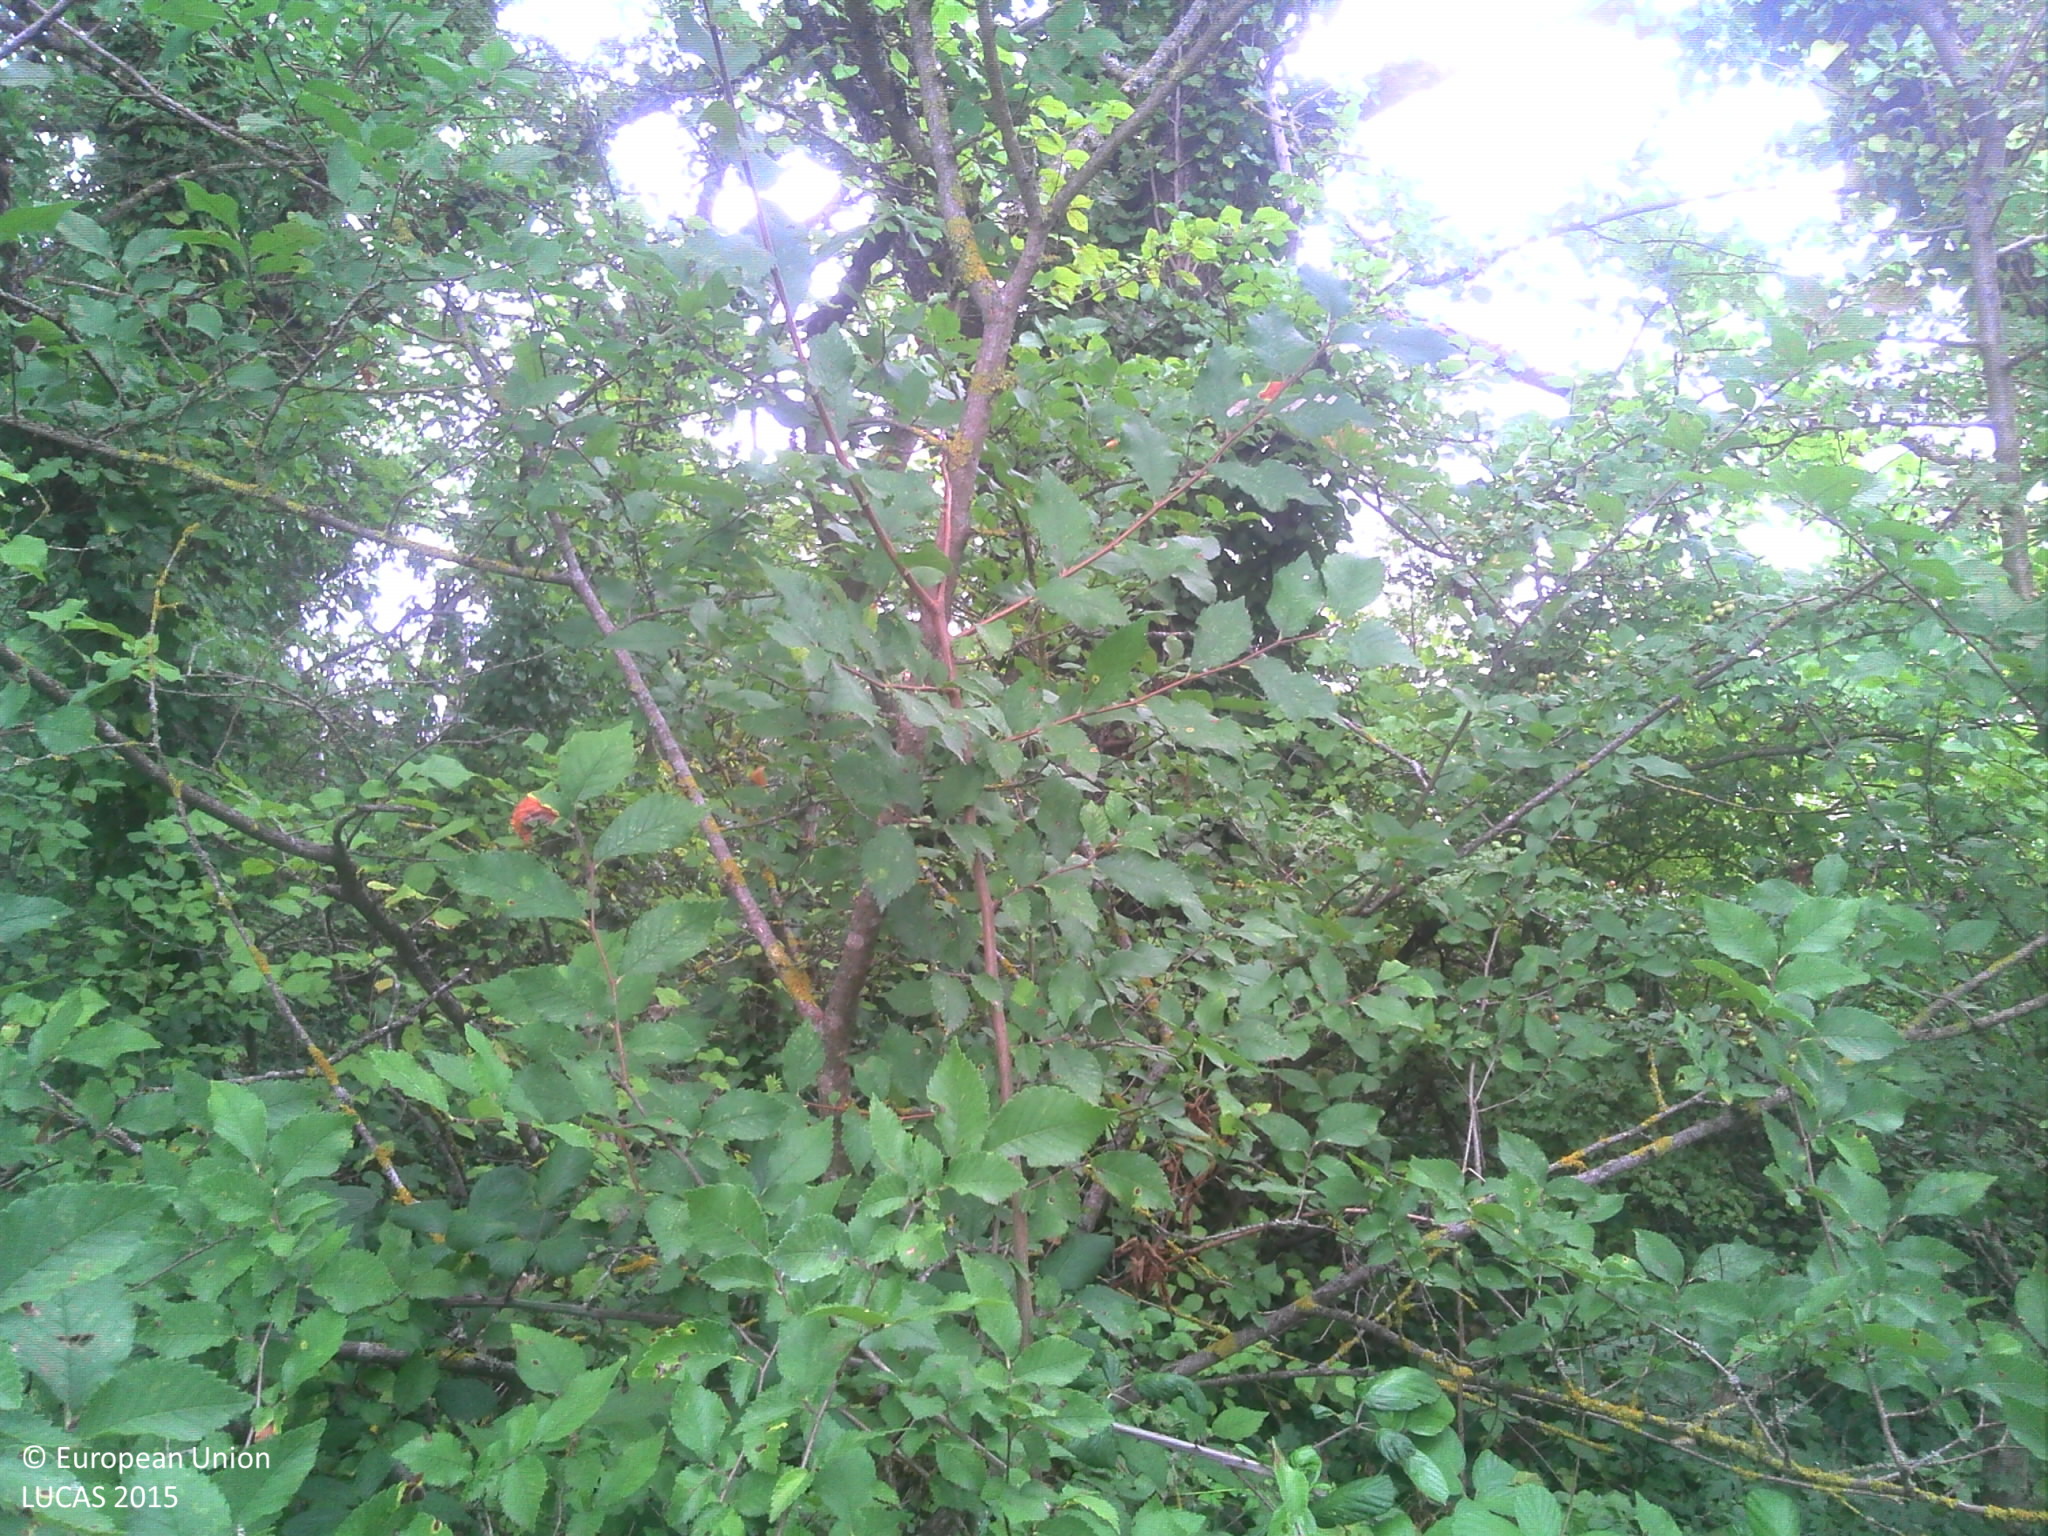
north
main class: Woodland
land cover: Broadleaved woodland
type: boreal forest
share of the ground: > 75 %
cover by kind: shrubs 50 %, broadleaved forest trees 40 %, herbaceous plants 10 %
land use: Forestry
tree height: > 5 m
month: August
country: FR
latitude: 43.5515
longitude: 1.3253
